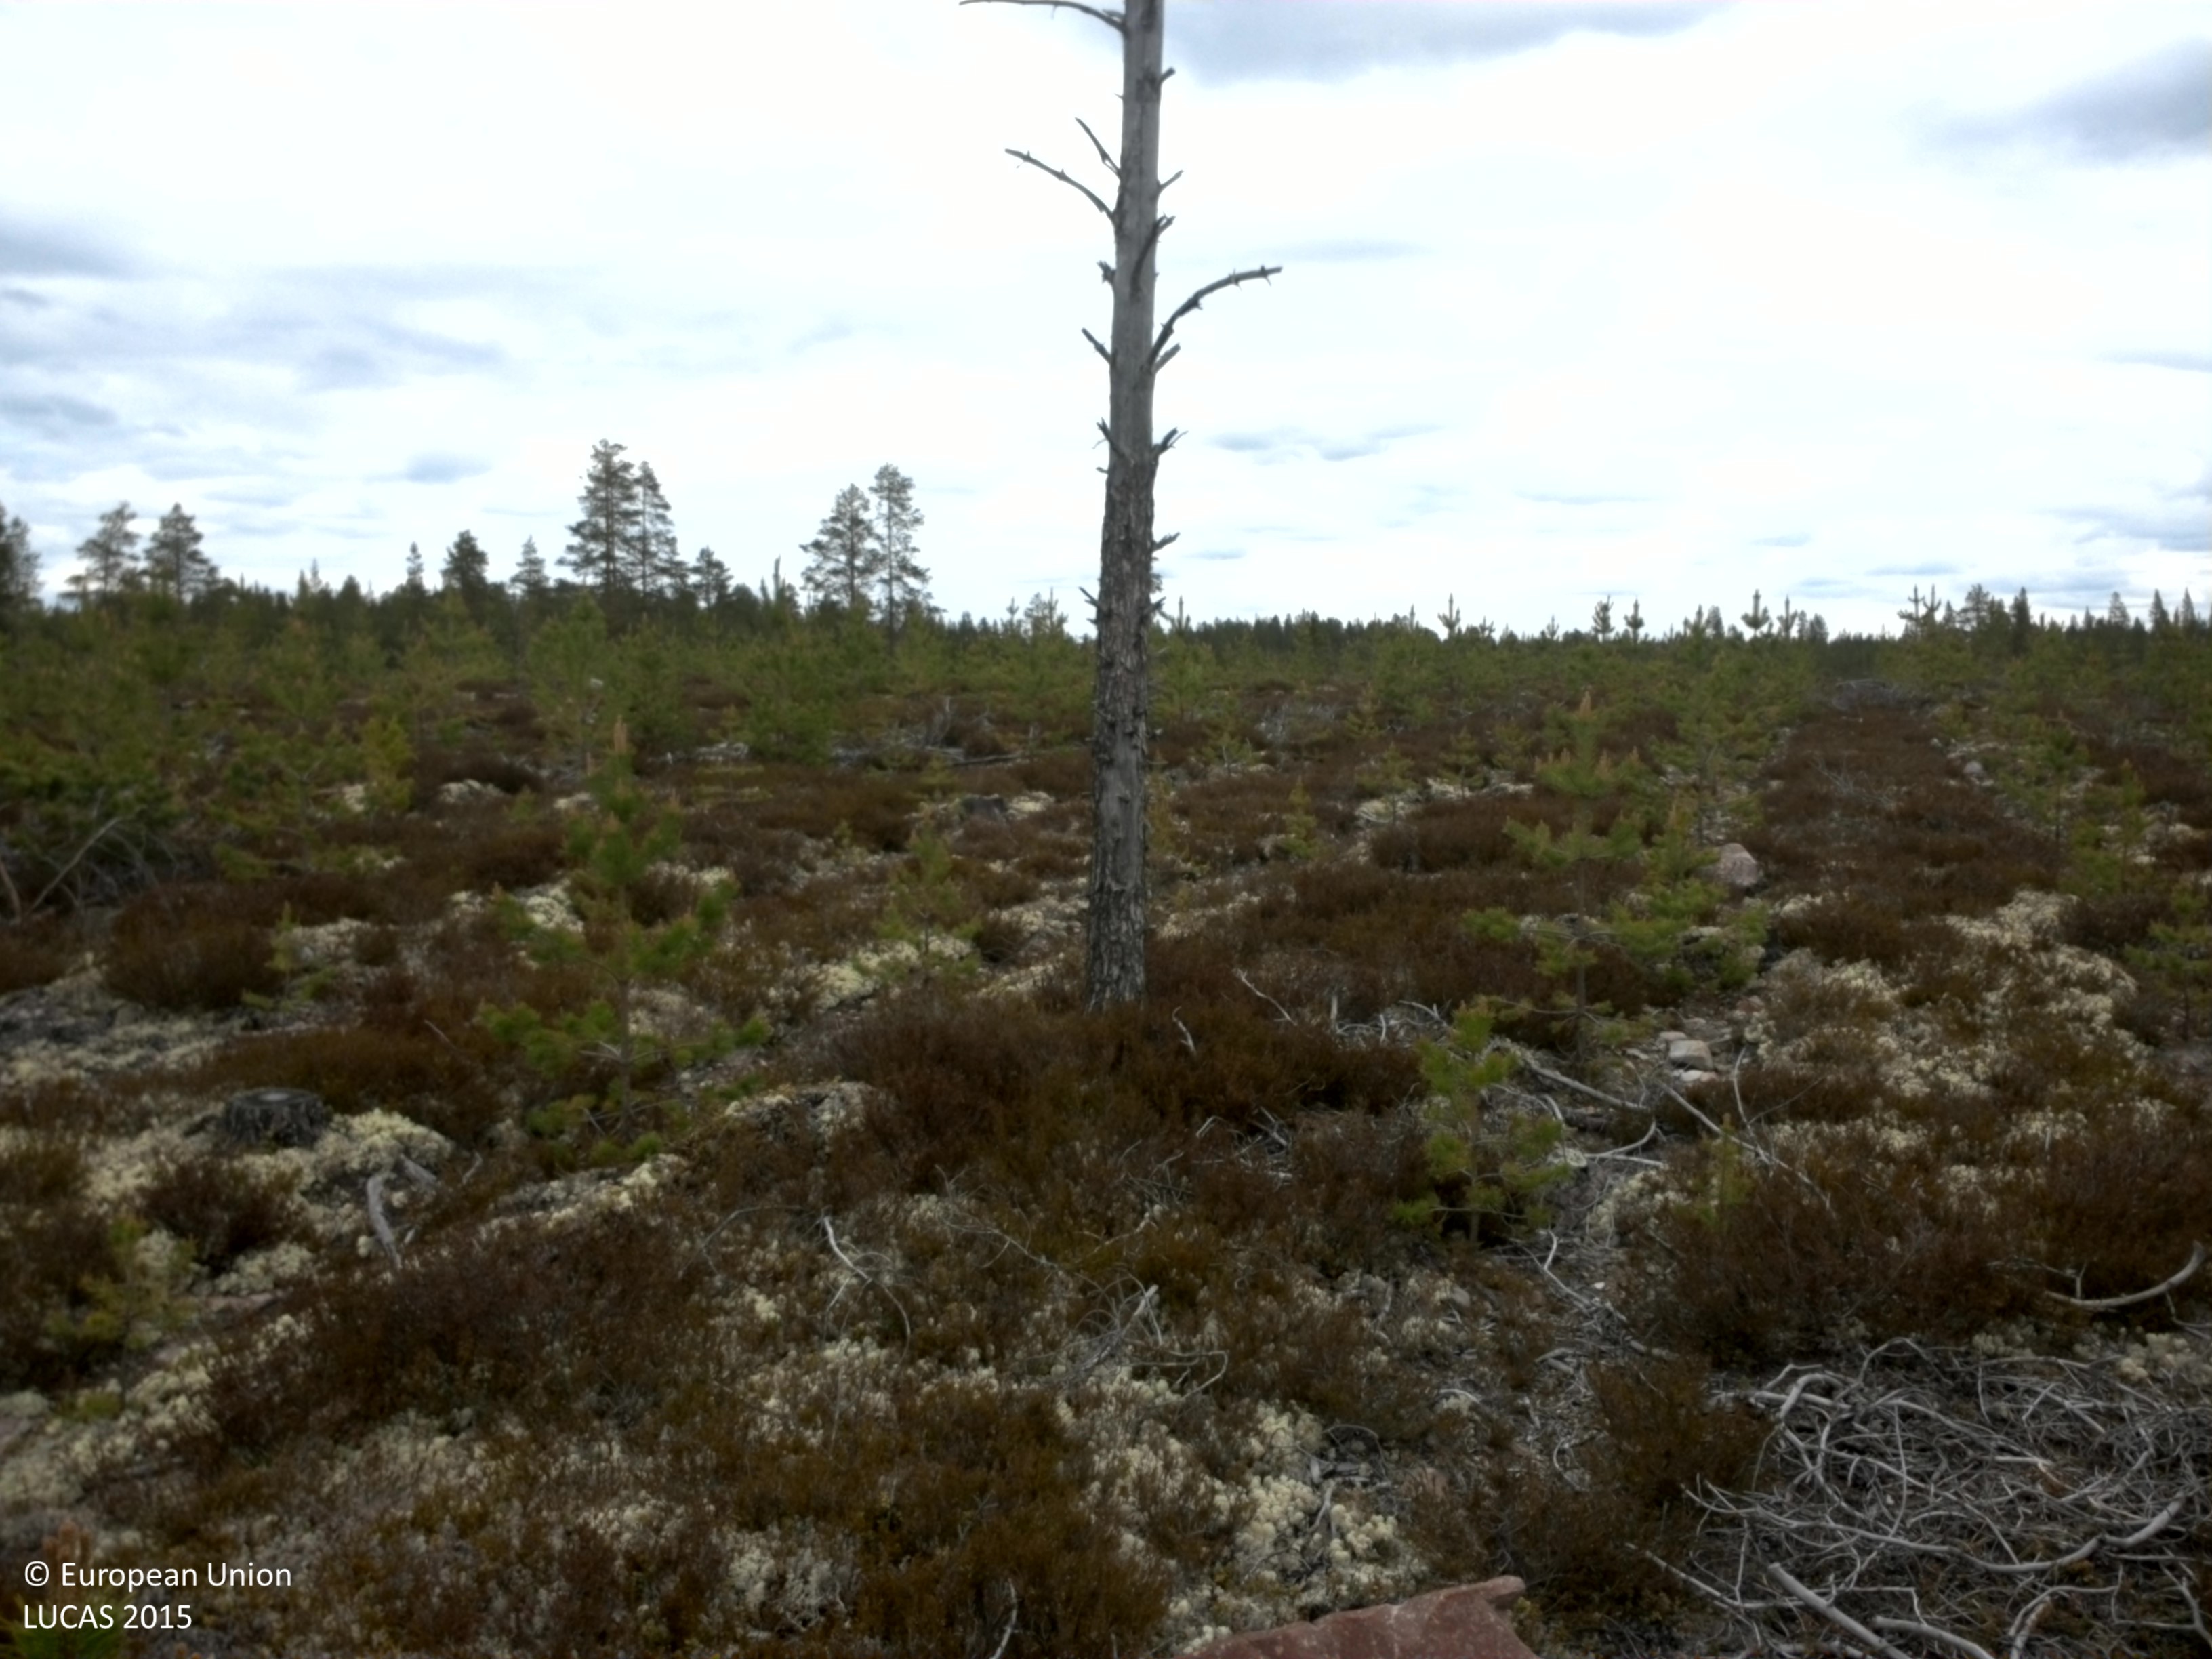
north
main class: Woodland
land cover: Pine dominated coniferous woodland
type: boreal forest
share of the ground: 10 - 25 %
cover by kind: lichens and mosses 30 %, coniferous forest trees 25 %, consolidated bare surface 20 %, shrubs 15 %, herbaceous plants 10 %
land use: Forestry
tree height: < 5 m
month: June
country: SE
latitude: 61.5638
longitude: 13.3948
